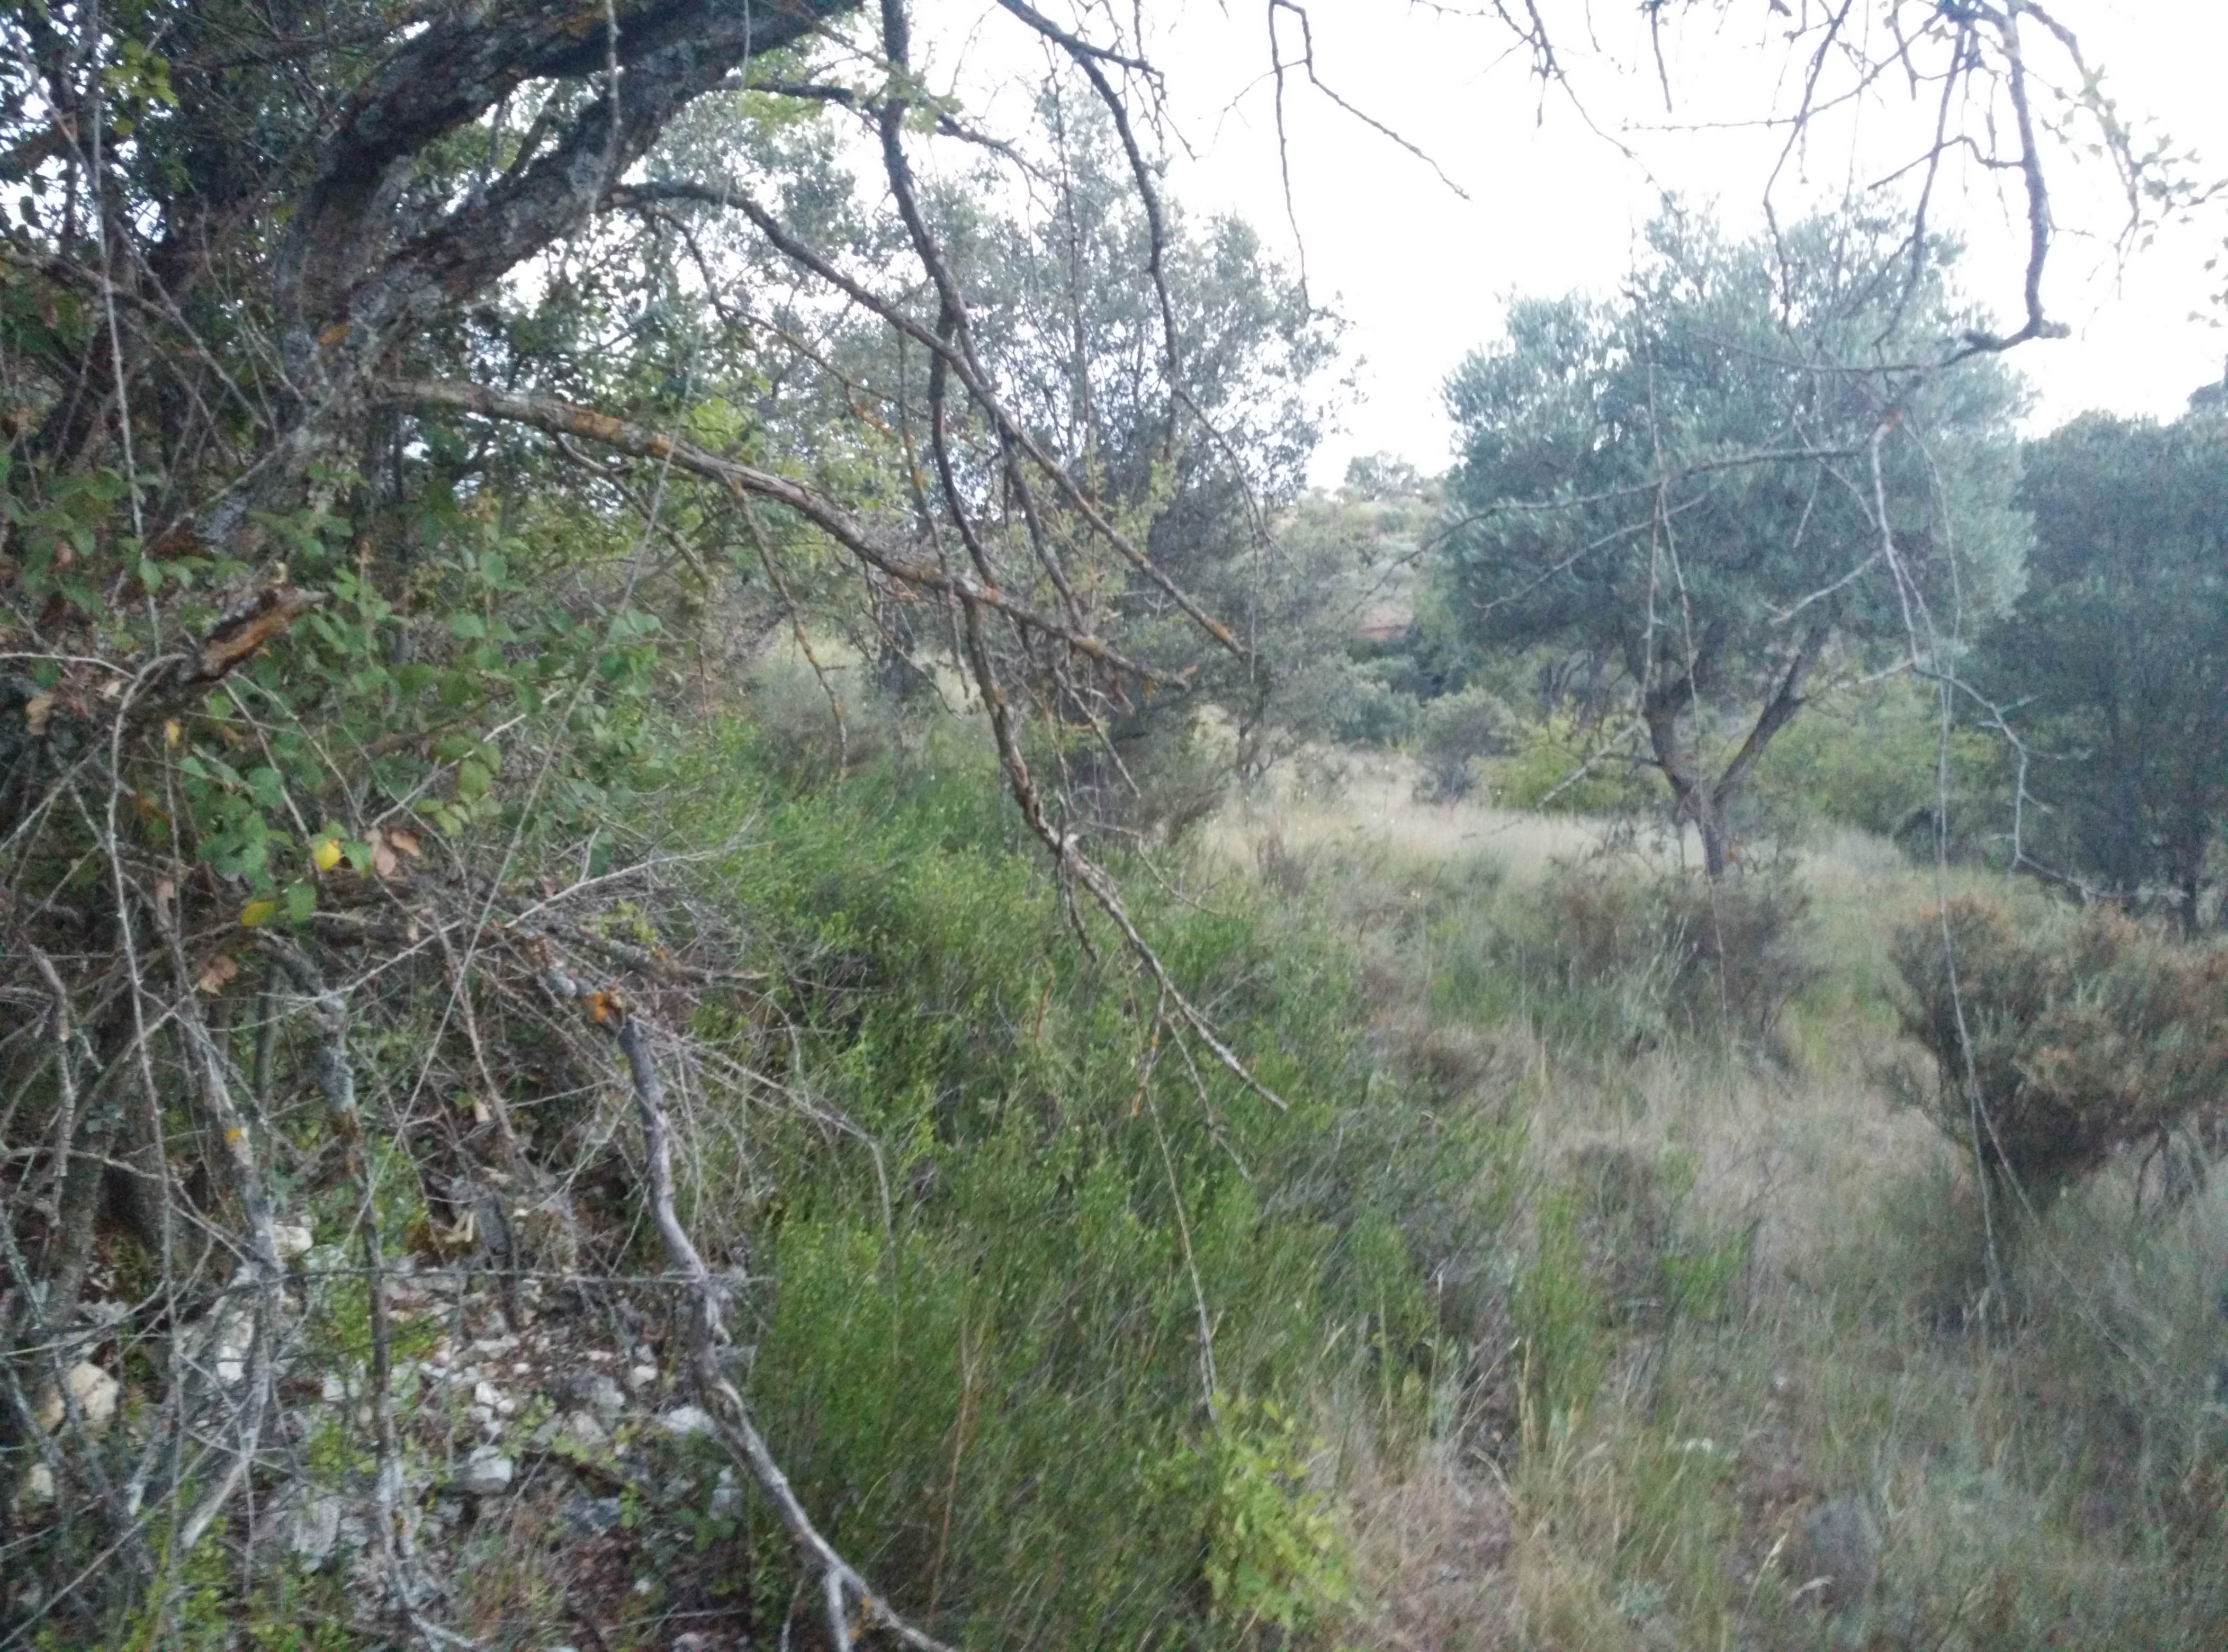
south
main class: Shrubland
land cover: Shrubland with sparse tree cover
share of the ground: 50 - 75 %
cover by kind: shrubs 60 %, unconsolidated bare surface 25 %, herbaceous plants 10 %, broadleaved forest trees 5 %
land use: Semi-natural and natural areas not in use
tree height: > 5 m
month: July
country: ES
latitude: 40.5567
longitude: -2.8184
